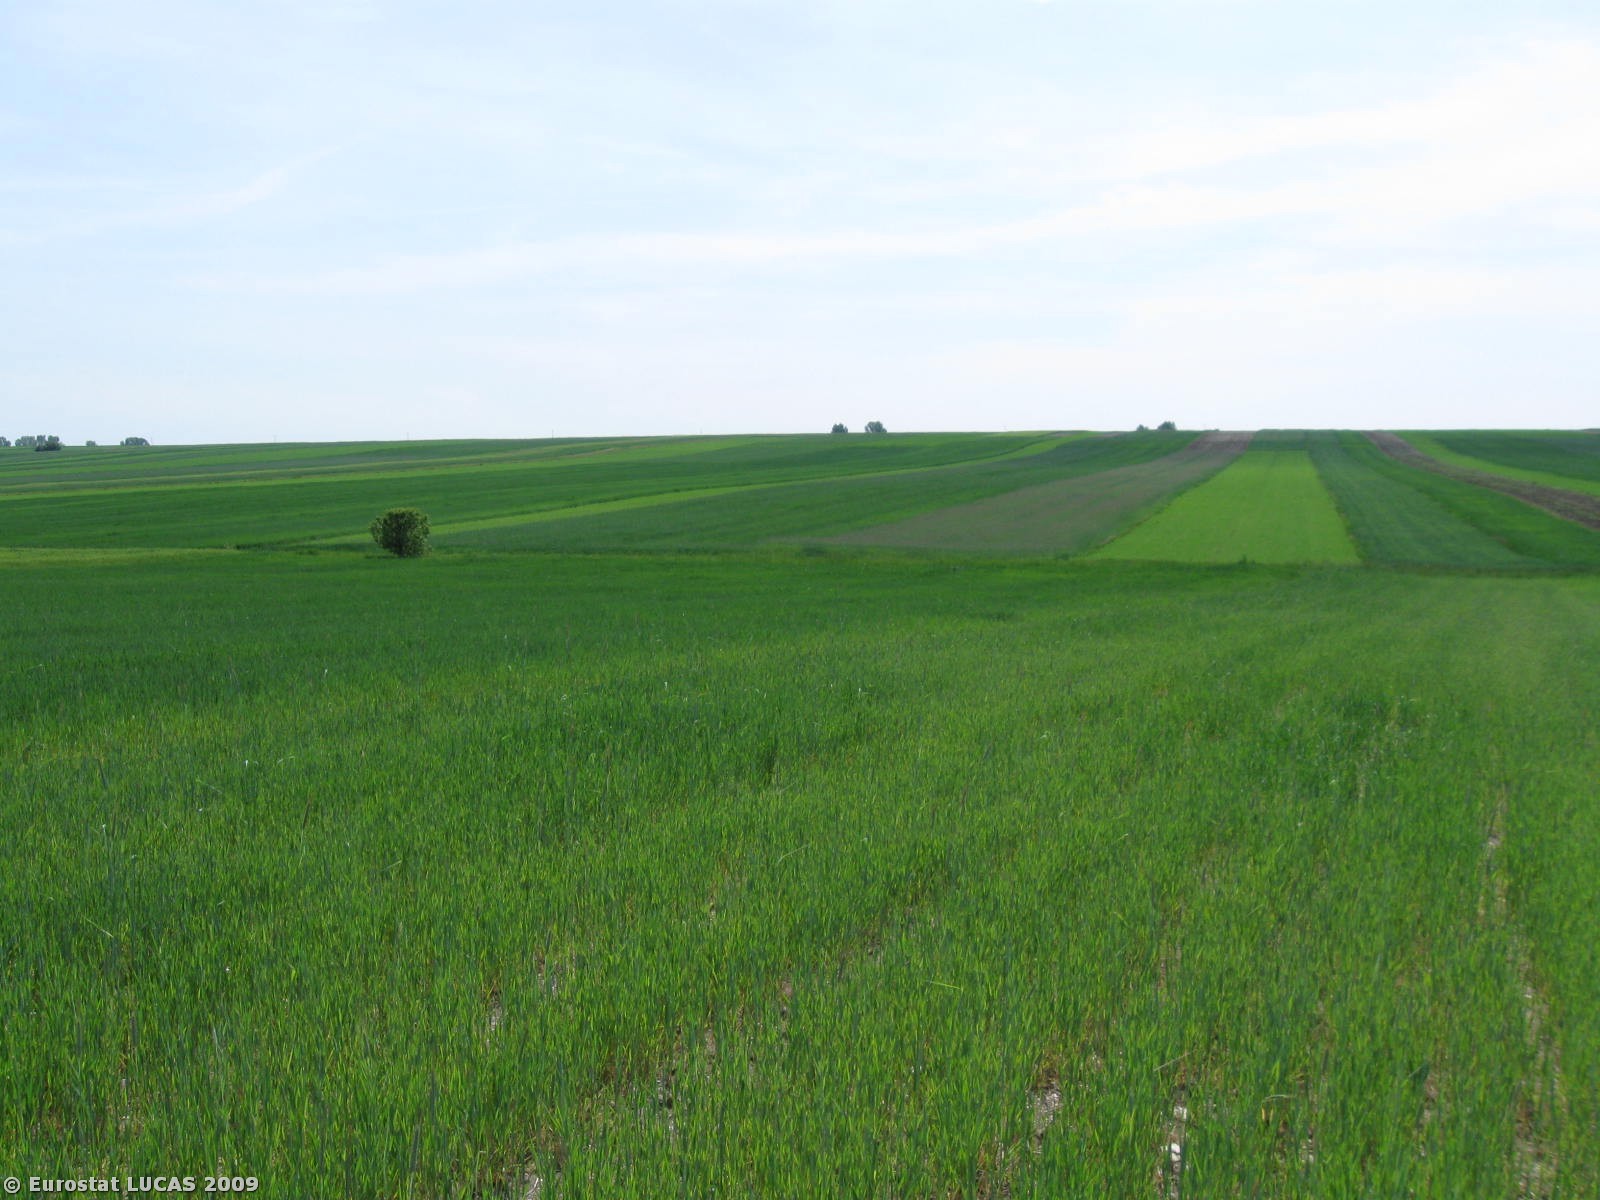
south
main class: Cropland
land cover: Rye
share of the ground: 50 - 75 %
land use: Agriculture (excluding fallow land and kitchen gardens)
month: May
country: PL
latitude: 50.6854
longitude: 20.4120
